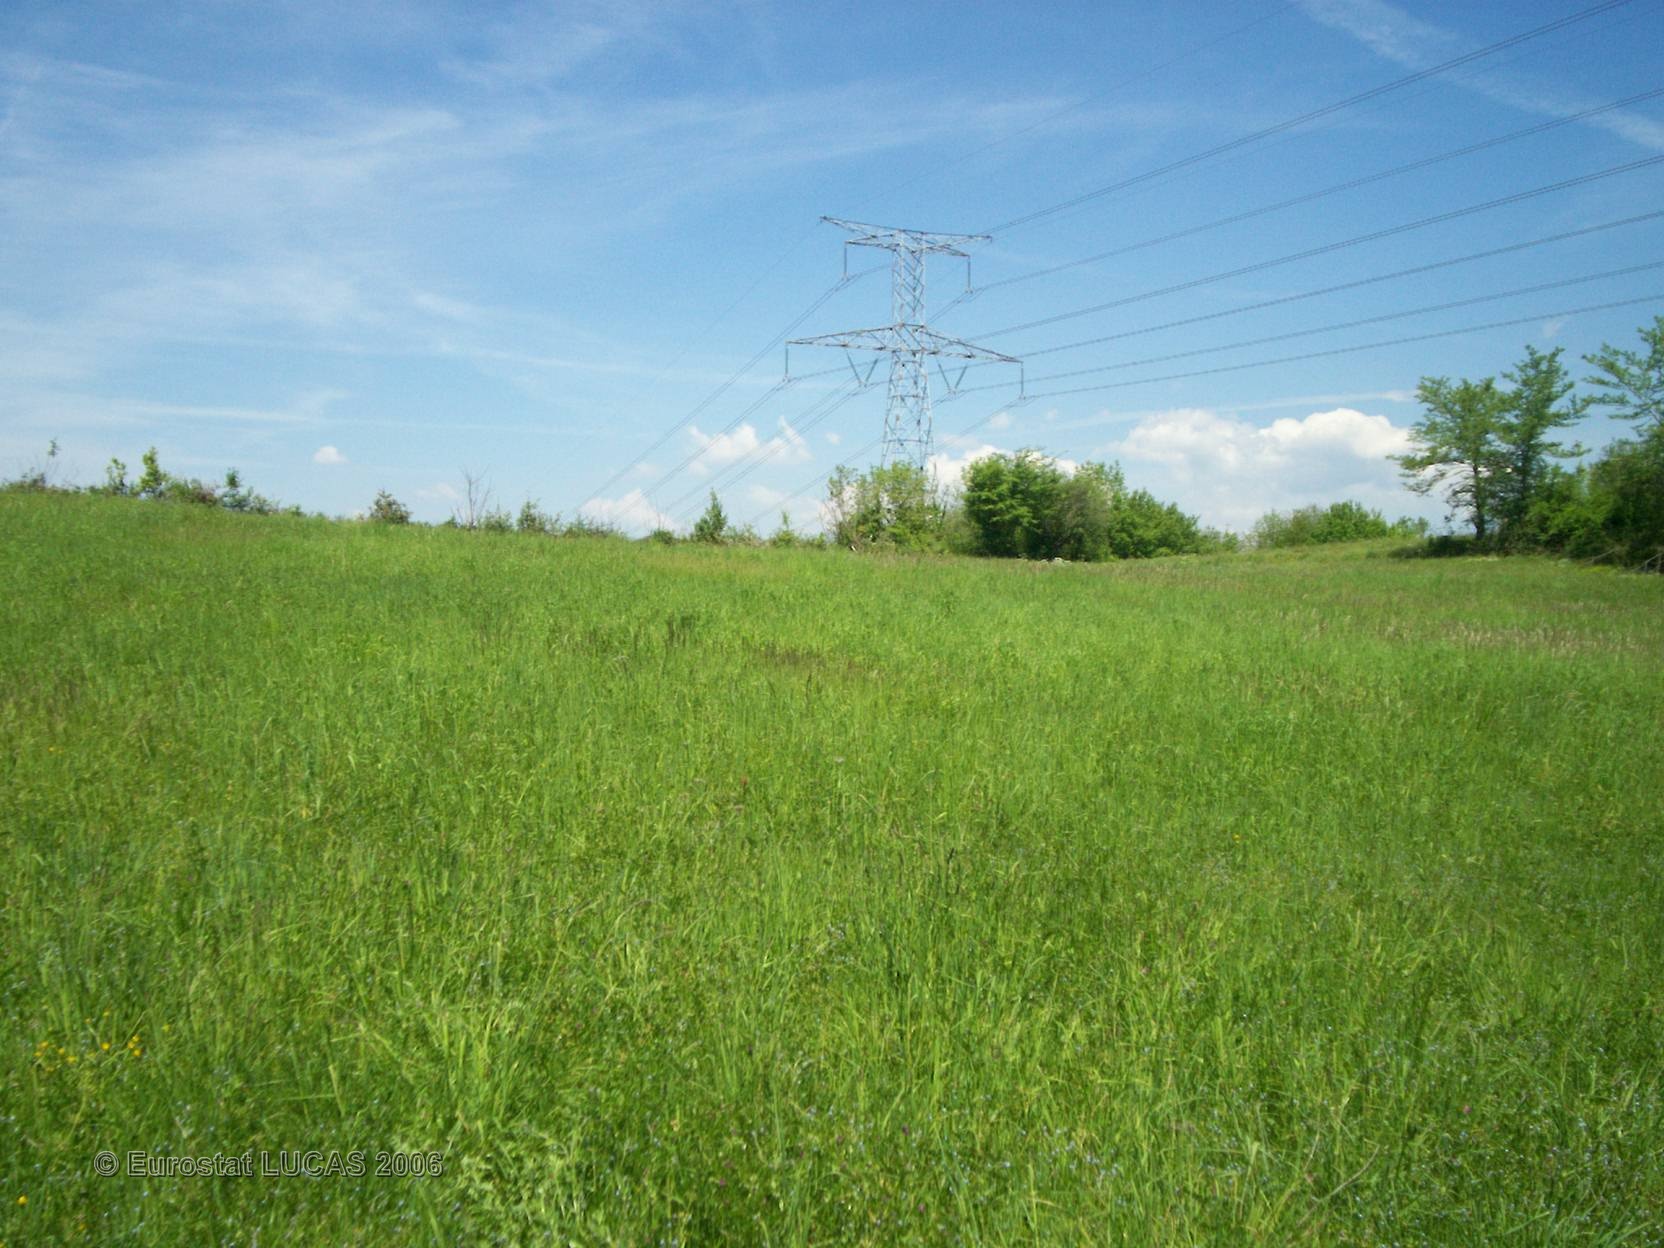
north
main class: Grassland
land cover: Grassland without tree/shrub cover
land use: Agriculture (excluding fallow land and kitchen gardens)
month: May
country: FR
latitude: 45.7320
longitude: 5.4679
